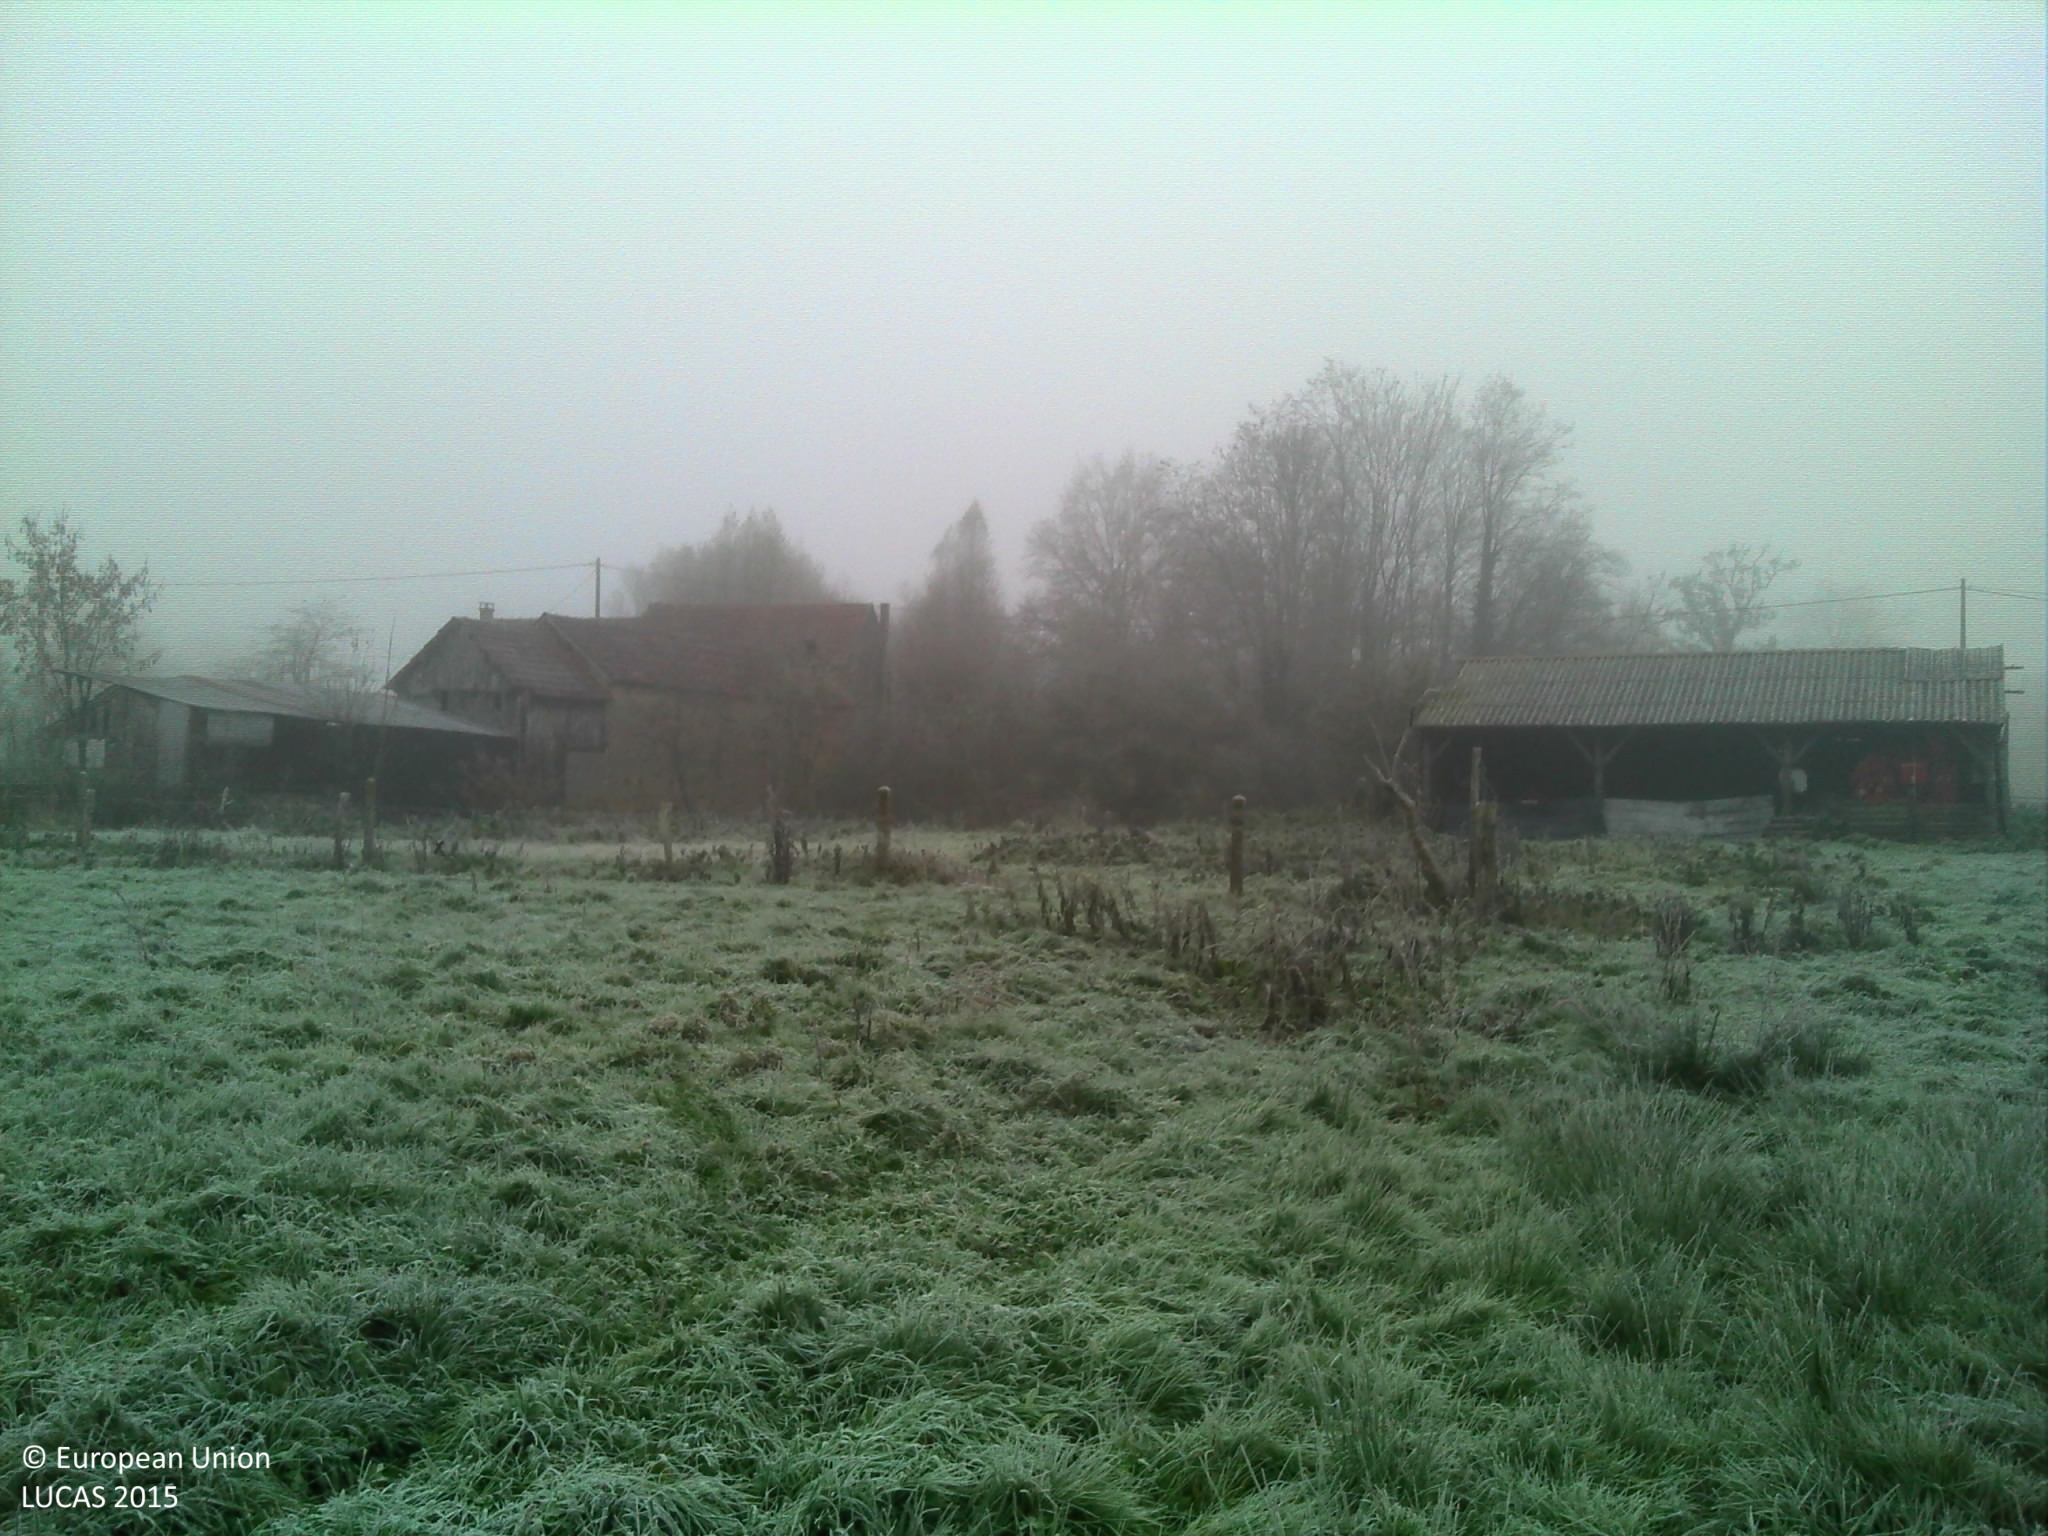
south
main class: Grassland
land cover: Grassland without tree/shrub cover
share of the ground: > 75 %
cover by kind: herbaceous plants 100 %
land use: Agriculture (excluding fallow land and kitchen gardens)
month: November
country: FR
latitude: 46.5792
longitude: 3.6703
